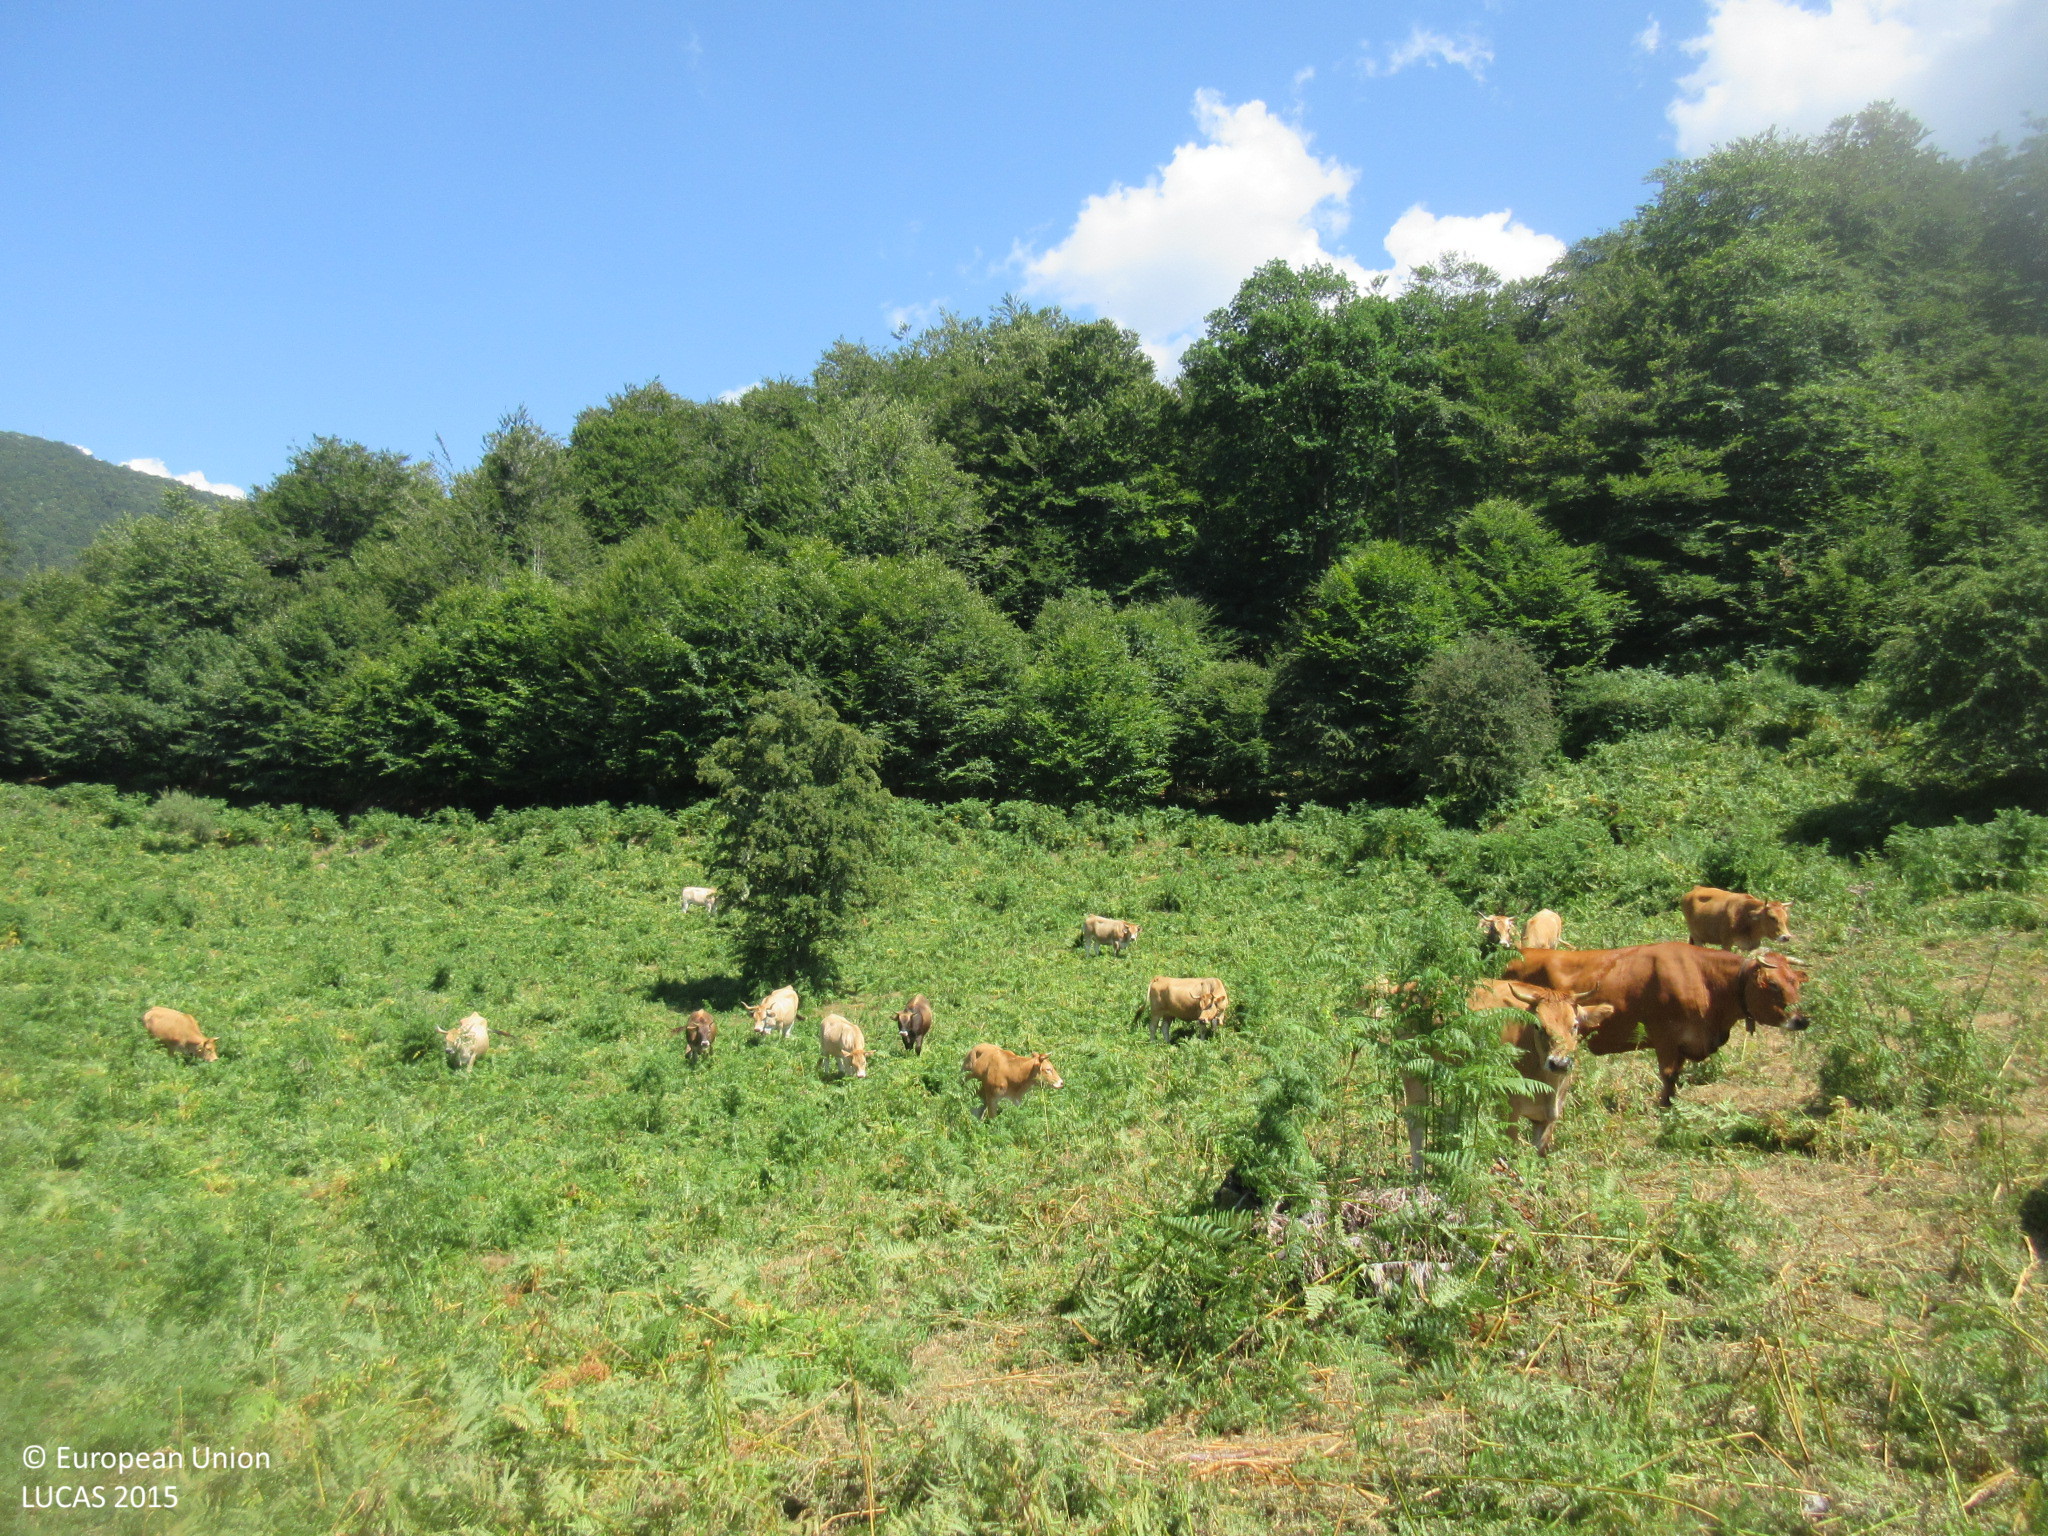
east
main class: Woodland
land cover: Broadleaved woodland
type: mountainous beech forest
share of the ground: > 75 %
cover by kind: broadleaved forest trees 100 %
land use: Forestry
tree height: > 5 m
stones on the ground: < 10 %
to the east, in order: Broadleaved woodland
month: July
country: ES
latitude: 43.1244
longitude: -5.0015
